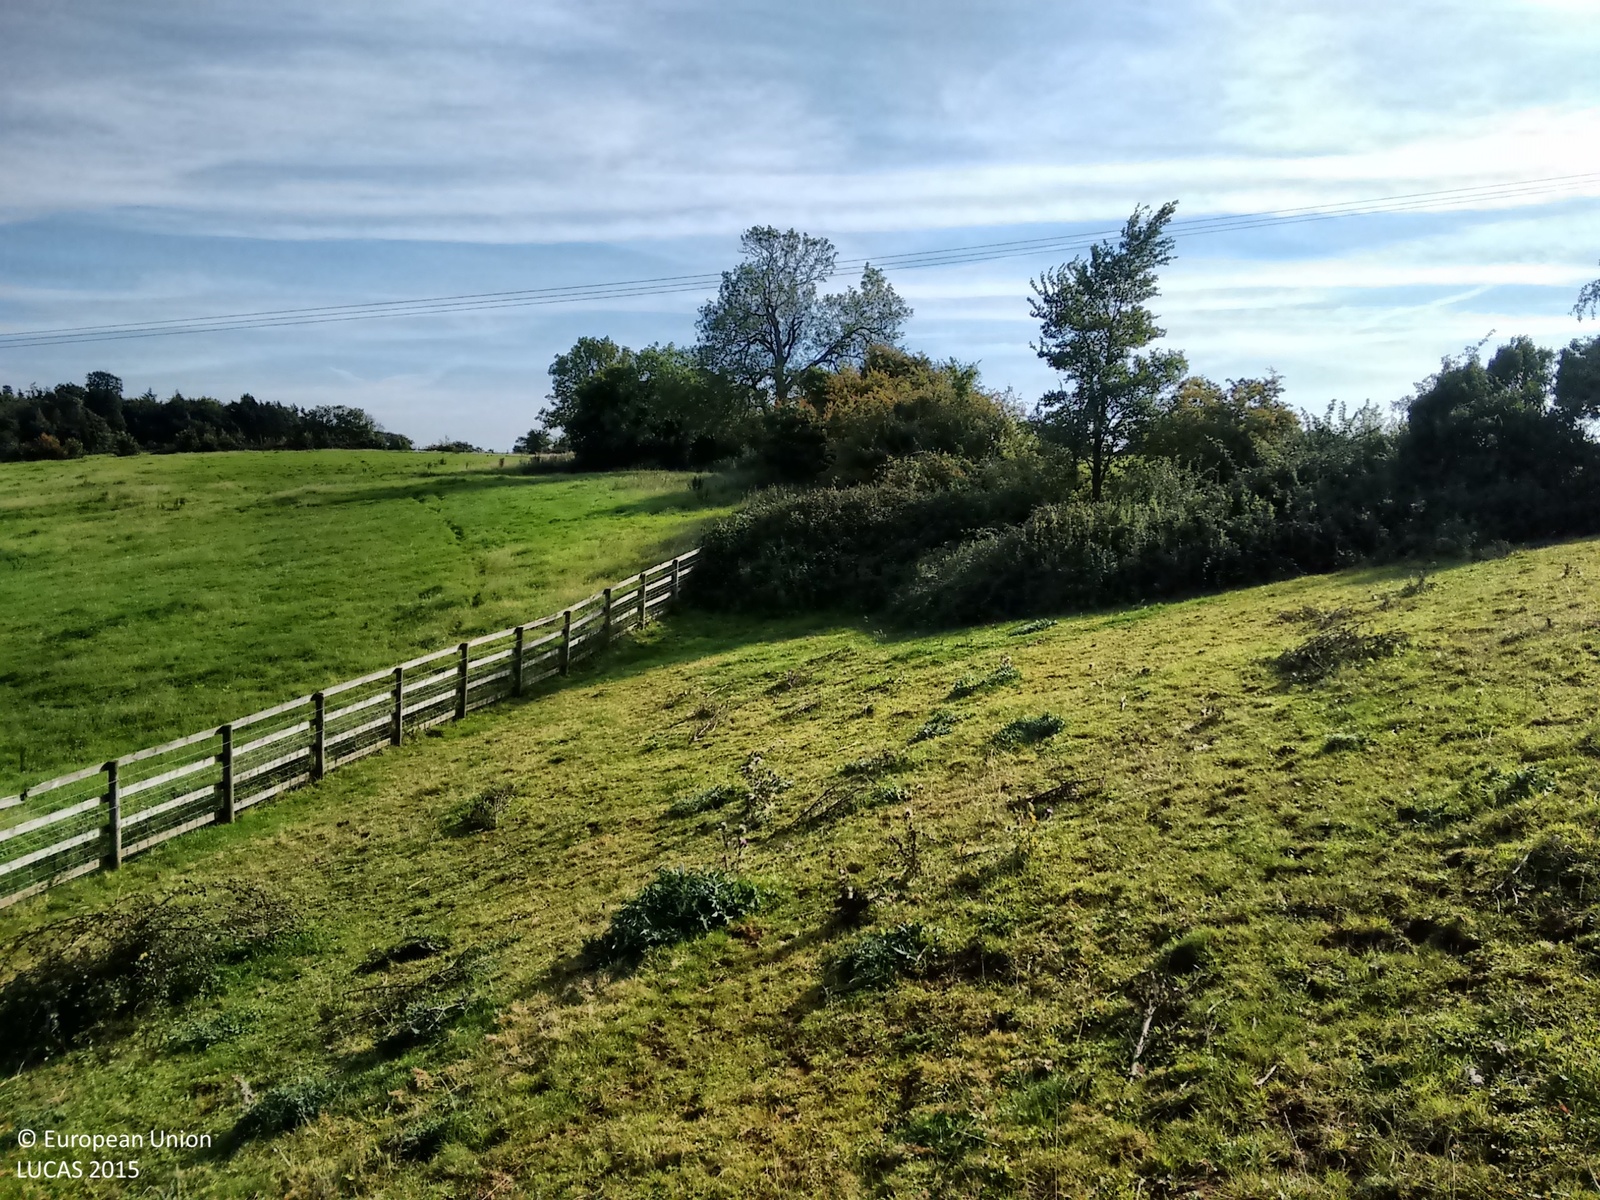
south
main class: Grassland
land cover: Grassland without tree/shrub cover
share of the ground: > 75 %
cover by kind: herbaceous plants 100 %
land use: Agriculture (excluding fallow land and kitchen gardens)
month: September
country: GB
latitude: 51.6783
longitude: -2.4893
